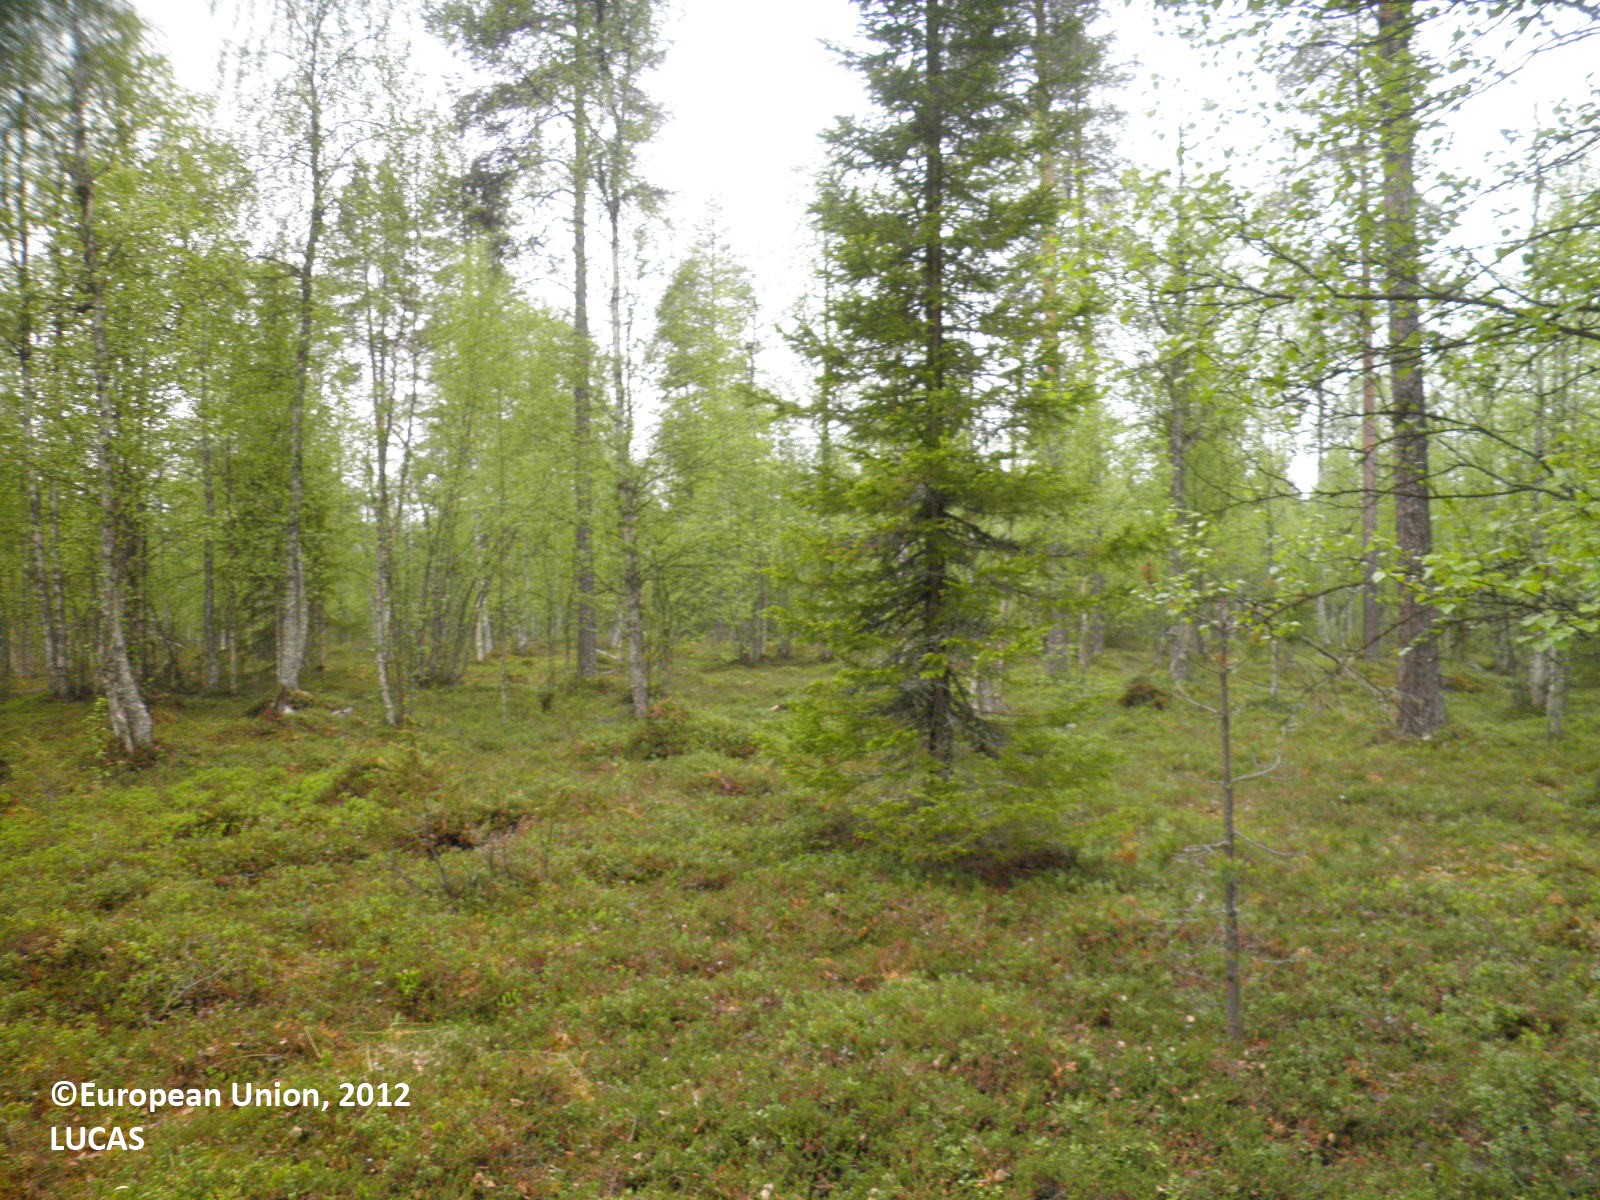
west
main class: Woodland
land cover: Pine dominated mixed woodland
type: boreal forest
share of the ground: 25 - 50 %
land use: Forestry
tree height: > 5 m
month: June
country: FI
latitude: 67.9312
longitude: 25.4728
